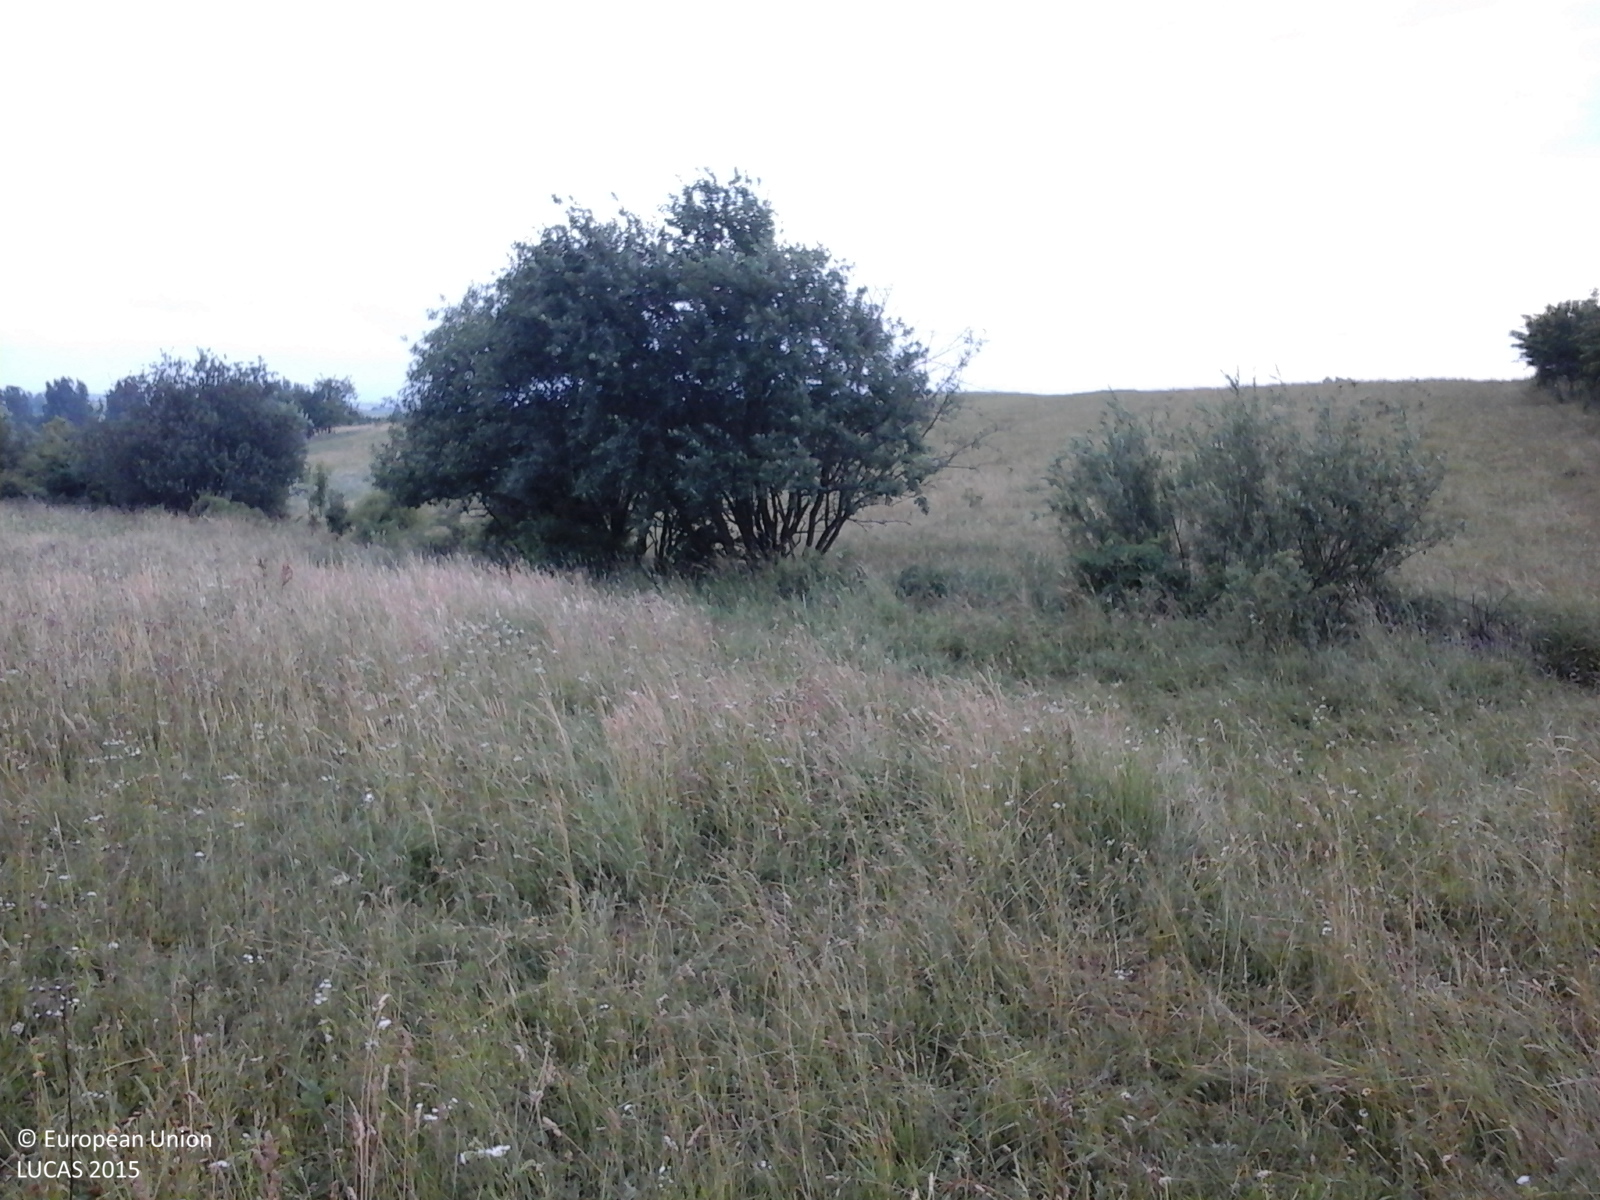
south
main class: Grassland
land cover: Grassland without tree/shrub cover
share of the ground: > 75 %
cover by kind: herbaceous plants 100 %
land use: Agriculture (excluding fallow land and kitchen gardens)
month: June
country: RO
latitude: 47.9694
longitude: 25.9498
